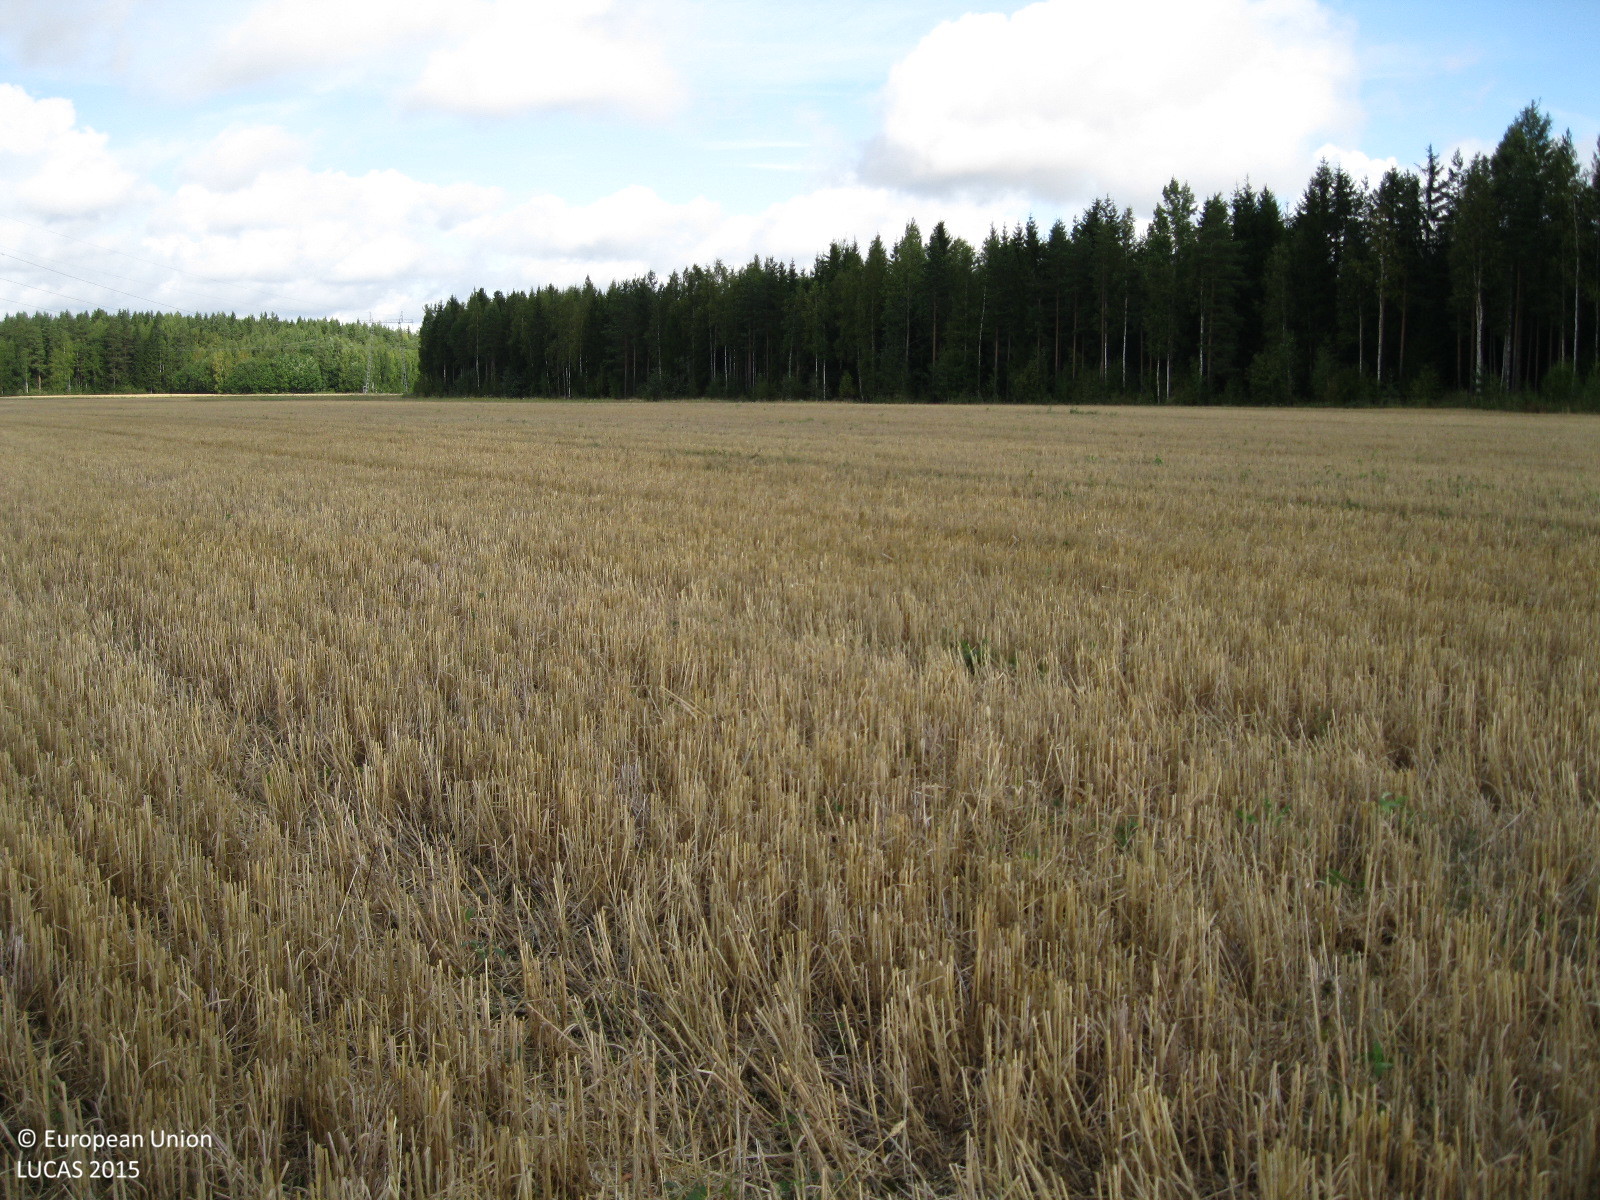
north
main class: Cropland
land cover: Common wheat
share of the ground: > 75 %
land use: Agriculture (excluding fallow land and kitchen gardens)
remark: Harvested field
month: September
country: FI
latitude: 60.8324
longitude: 24.9202
